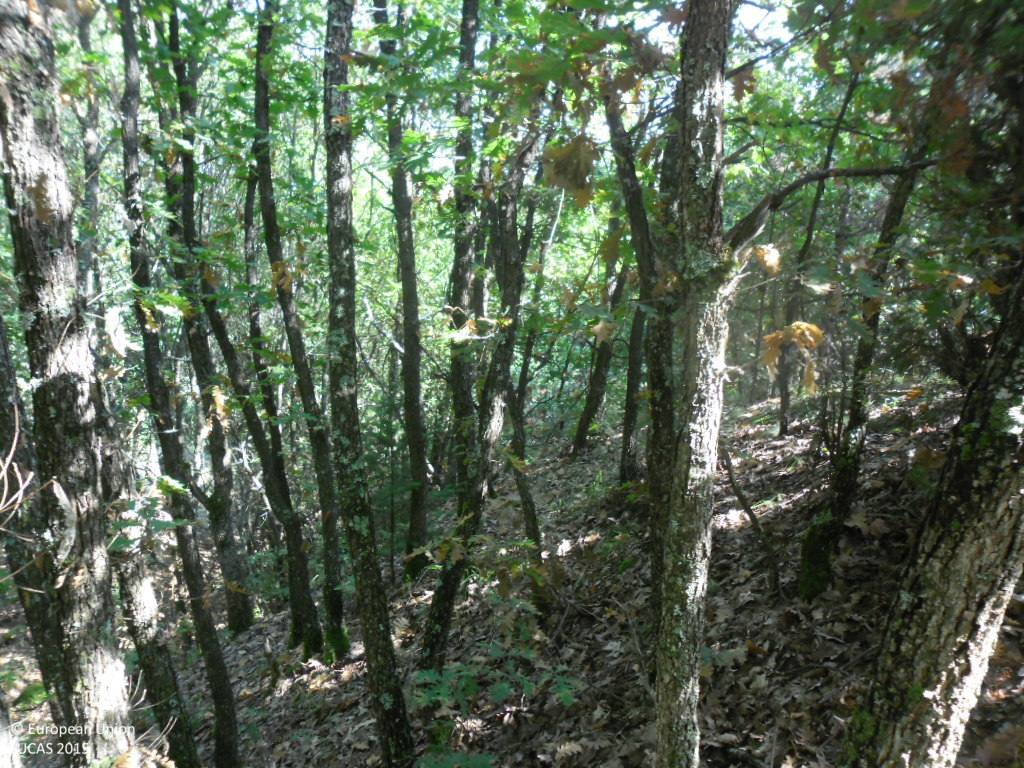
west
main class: Woodland
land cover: Broadleaved woodland
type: mesophytic deciduous forest
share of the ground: > 75 %
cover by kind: broadleaved forest trees 95 %, unconsolidated bare surface 5 %
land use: Forestry
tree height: < 5 m
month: September
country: BG
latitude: 41.9092
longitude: 22.9571
